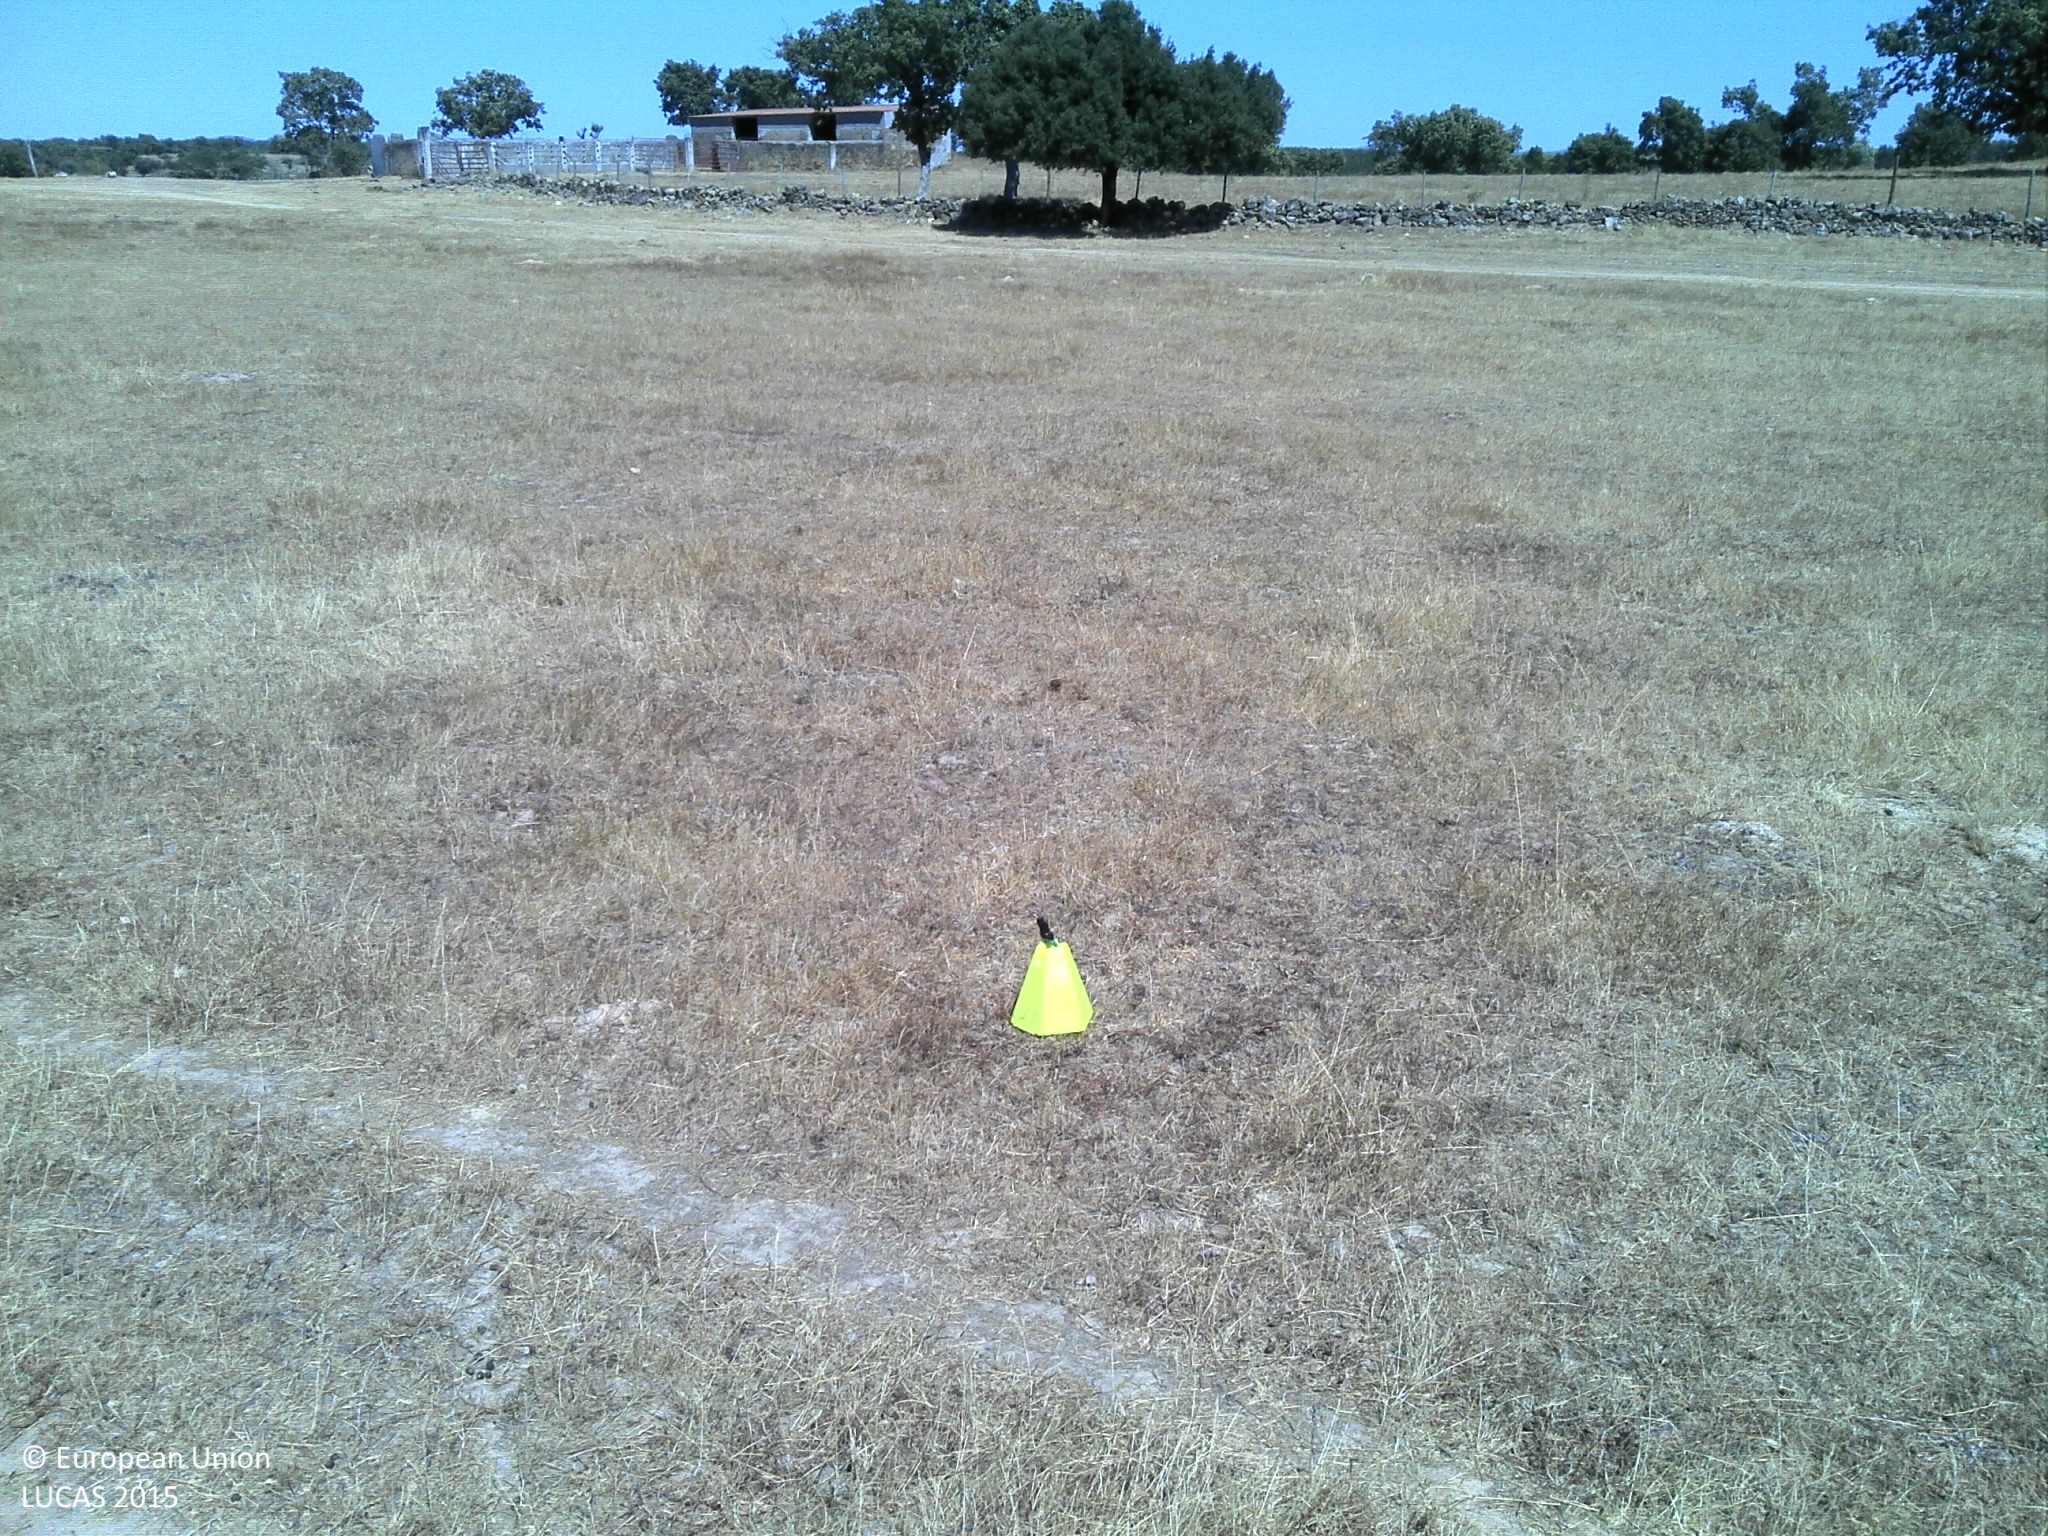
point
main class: Grassland
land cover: Grassland without tree/shrub cover
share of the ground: 10 - 25 %
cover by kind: unconsolidated bare surface 90 %, herbaceous plants 10 %
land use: Agriculture (excluding fallow land and kitchen gardens)
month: July
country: PT
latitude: 39.3584
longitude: -7.6296
